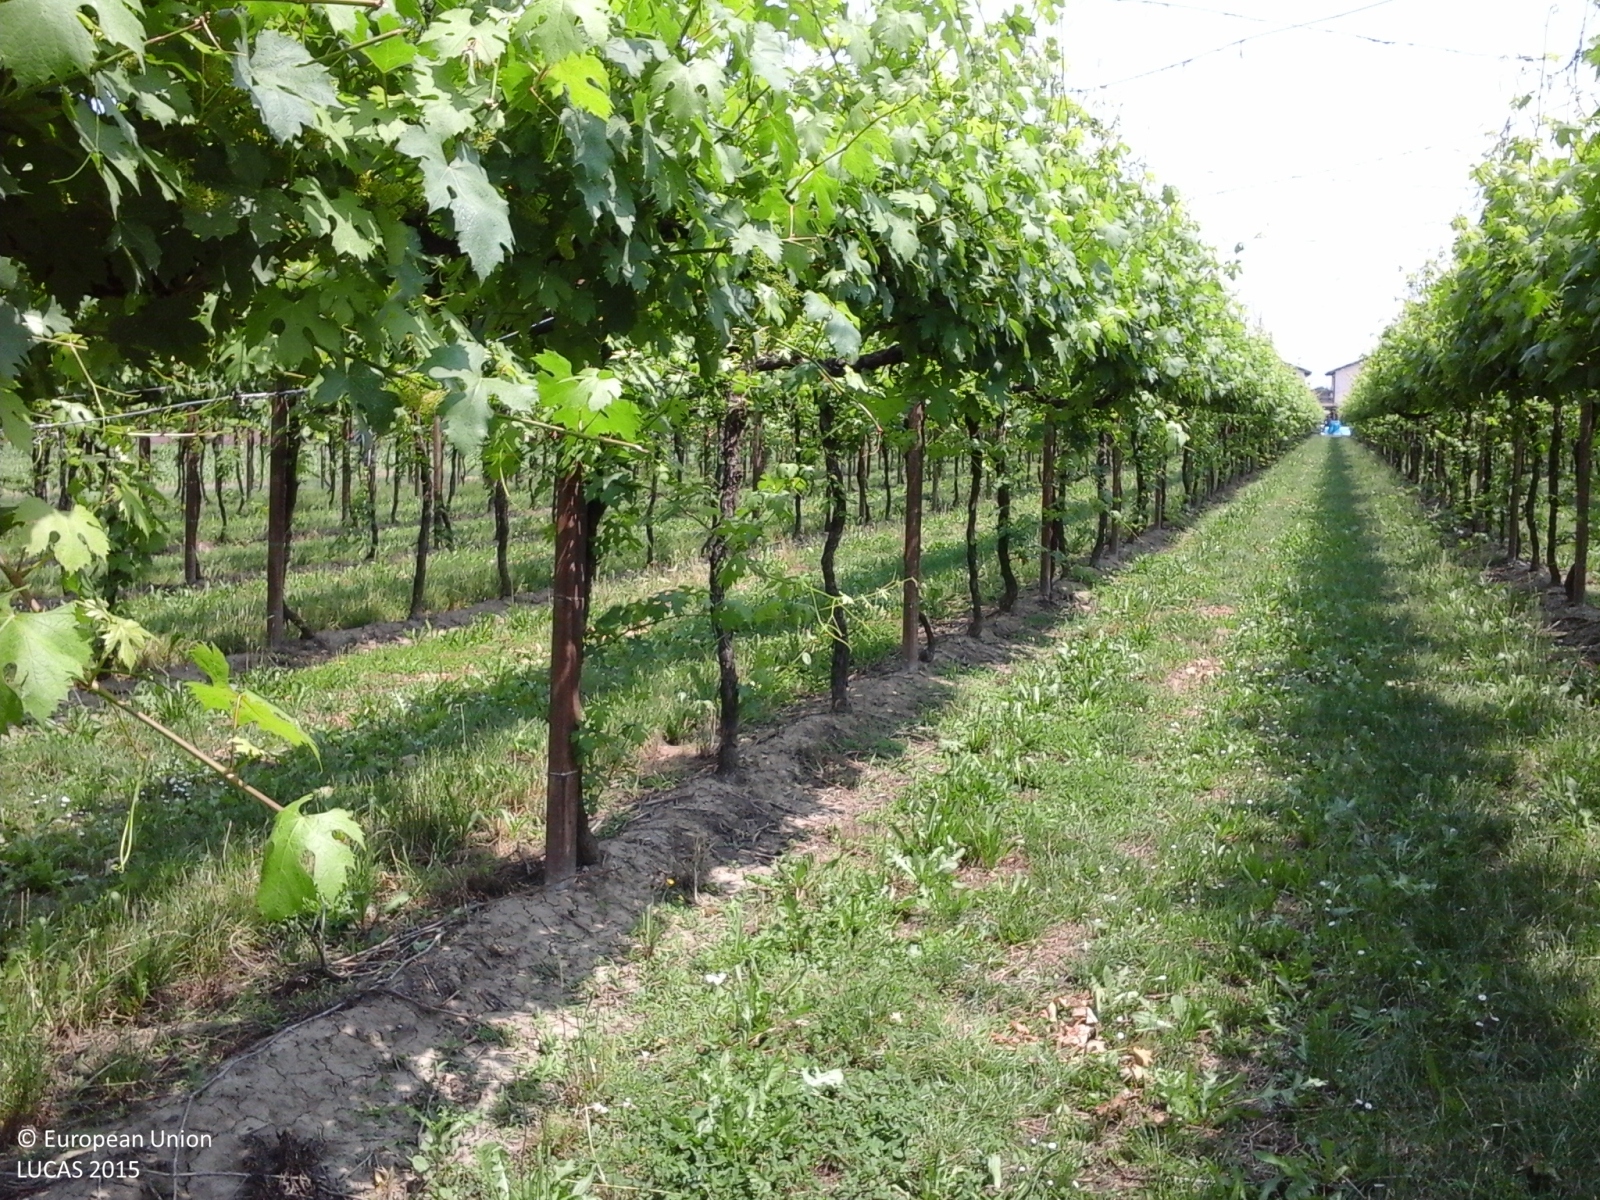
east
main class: Cropland
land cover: Vineyards
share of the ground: 50 - 75 %
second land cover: Grassland without tree/shrub cover
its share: > 75 %
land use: Agriculture (excluding fallow land and kitchen gardens)
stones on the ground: < 10 %
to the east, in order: Vineyards; Grassland without tree/shrub cover; Electric lines; Tracks; Lines of trees; Grassland without tree/shrub cover; Artificial constructions in urban areas
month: May
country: IT
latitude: 44.7987
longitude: 10.7443
